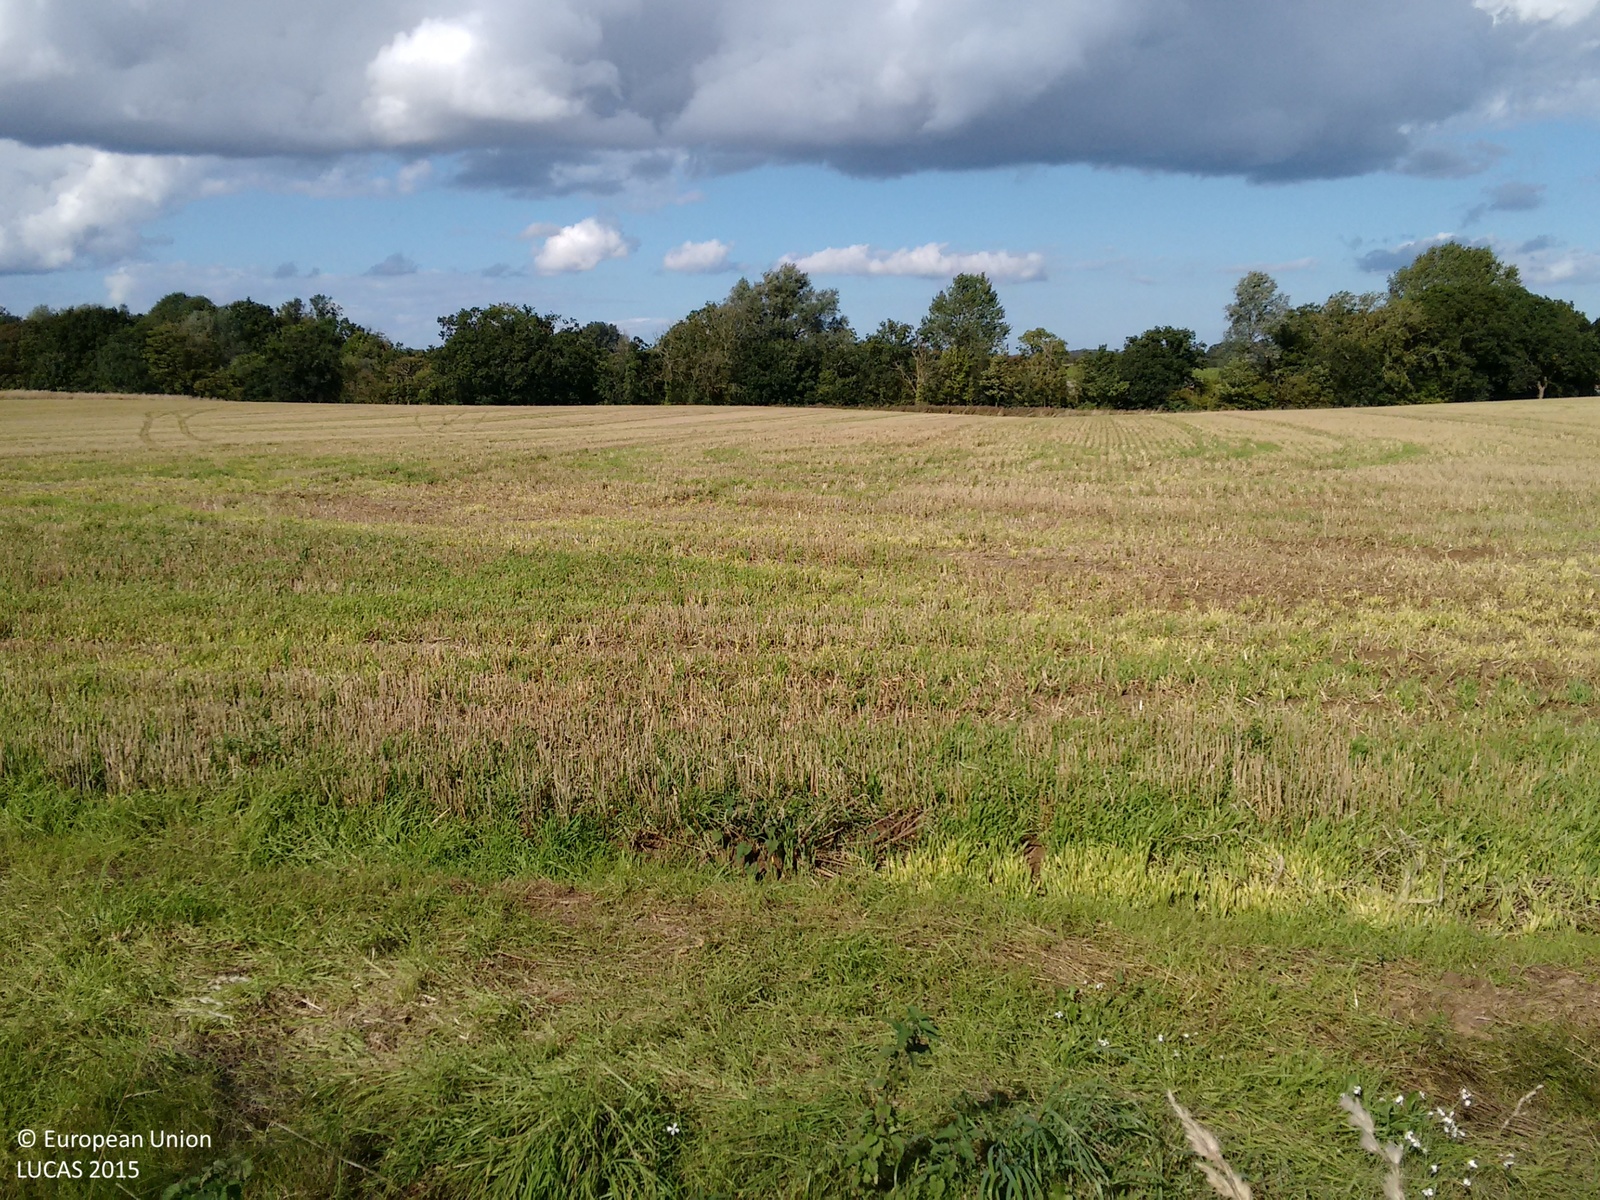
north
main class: Grassland
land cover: Grassland without tree/shrub cover
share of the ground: > 75 %
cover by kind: herbaceous plants 100 %
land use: Agriculture (excluding fallow land and kitchen gardens)
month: September
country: GB
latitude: 52.8171
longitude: 1.2994
